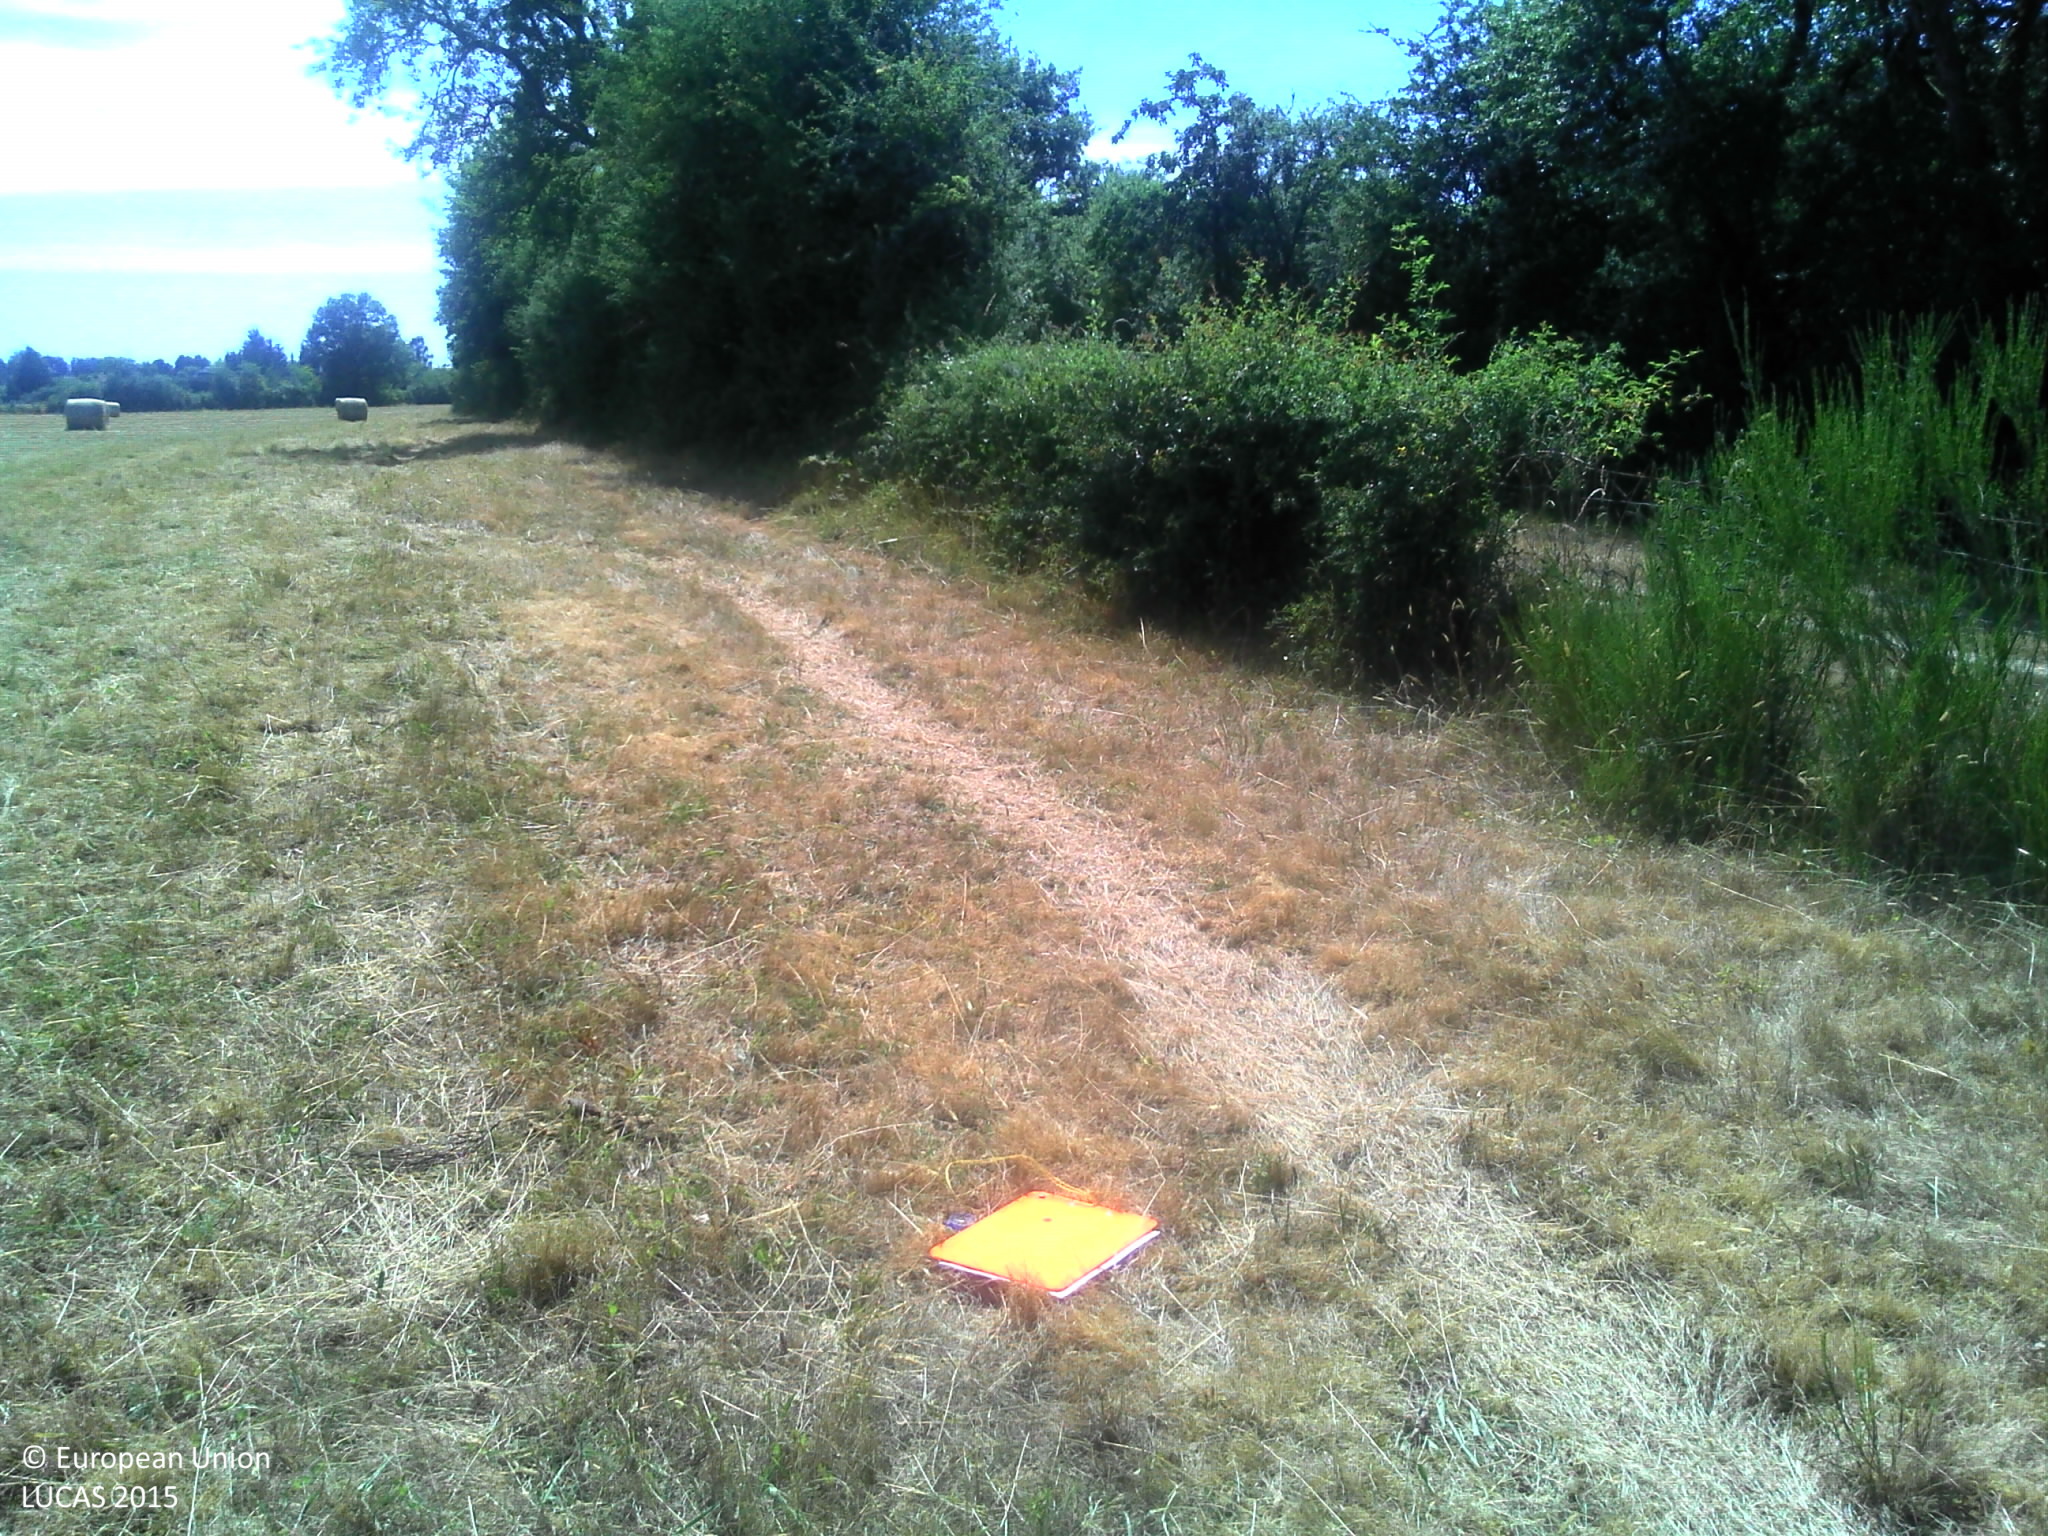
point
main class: Grassland
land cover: Grassland without tree/shrub cover
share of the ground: > 75 %
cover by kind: herbaceous plants 100 %
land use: Agriculture (excluding fallow land and kitchen gardens)
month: June
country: FR
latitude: 47.7713
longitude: 2.5321
